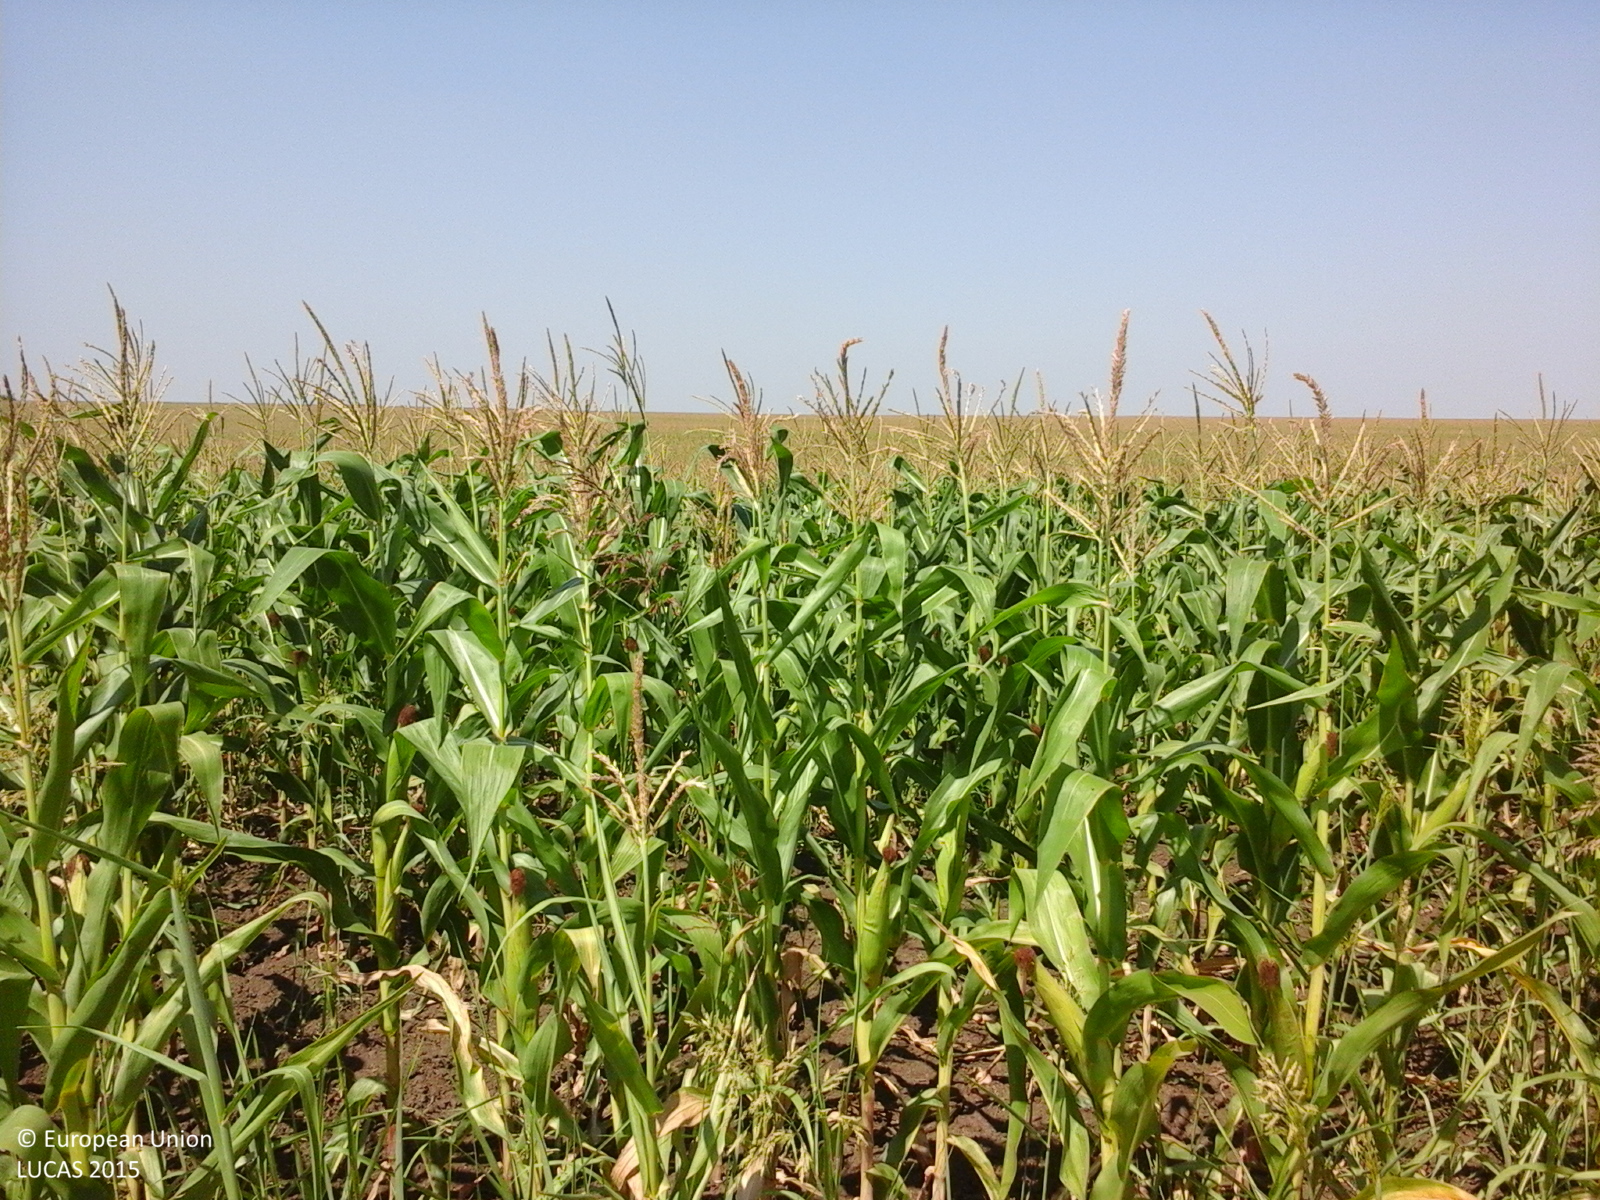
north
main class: Cropland
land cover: Maize
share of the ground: > 75 %
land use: Agriculture (excluding fallow land and kitchen gardens)
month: July
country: RO
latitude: 44.2738
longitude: 27.0283
